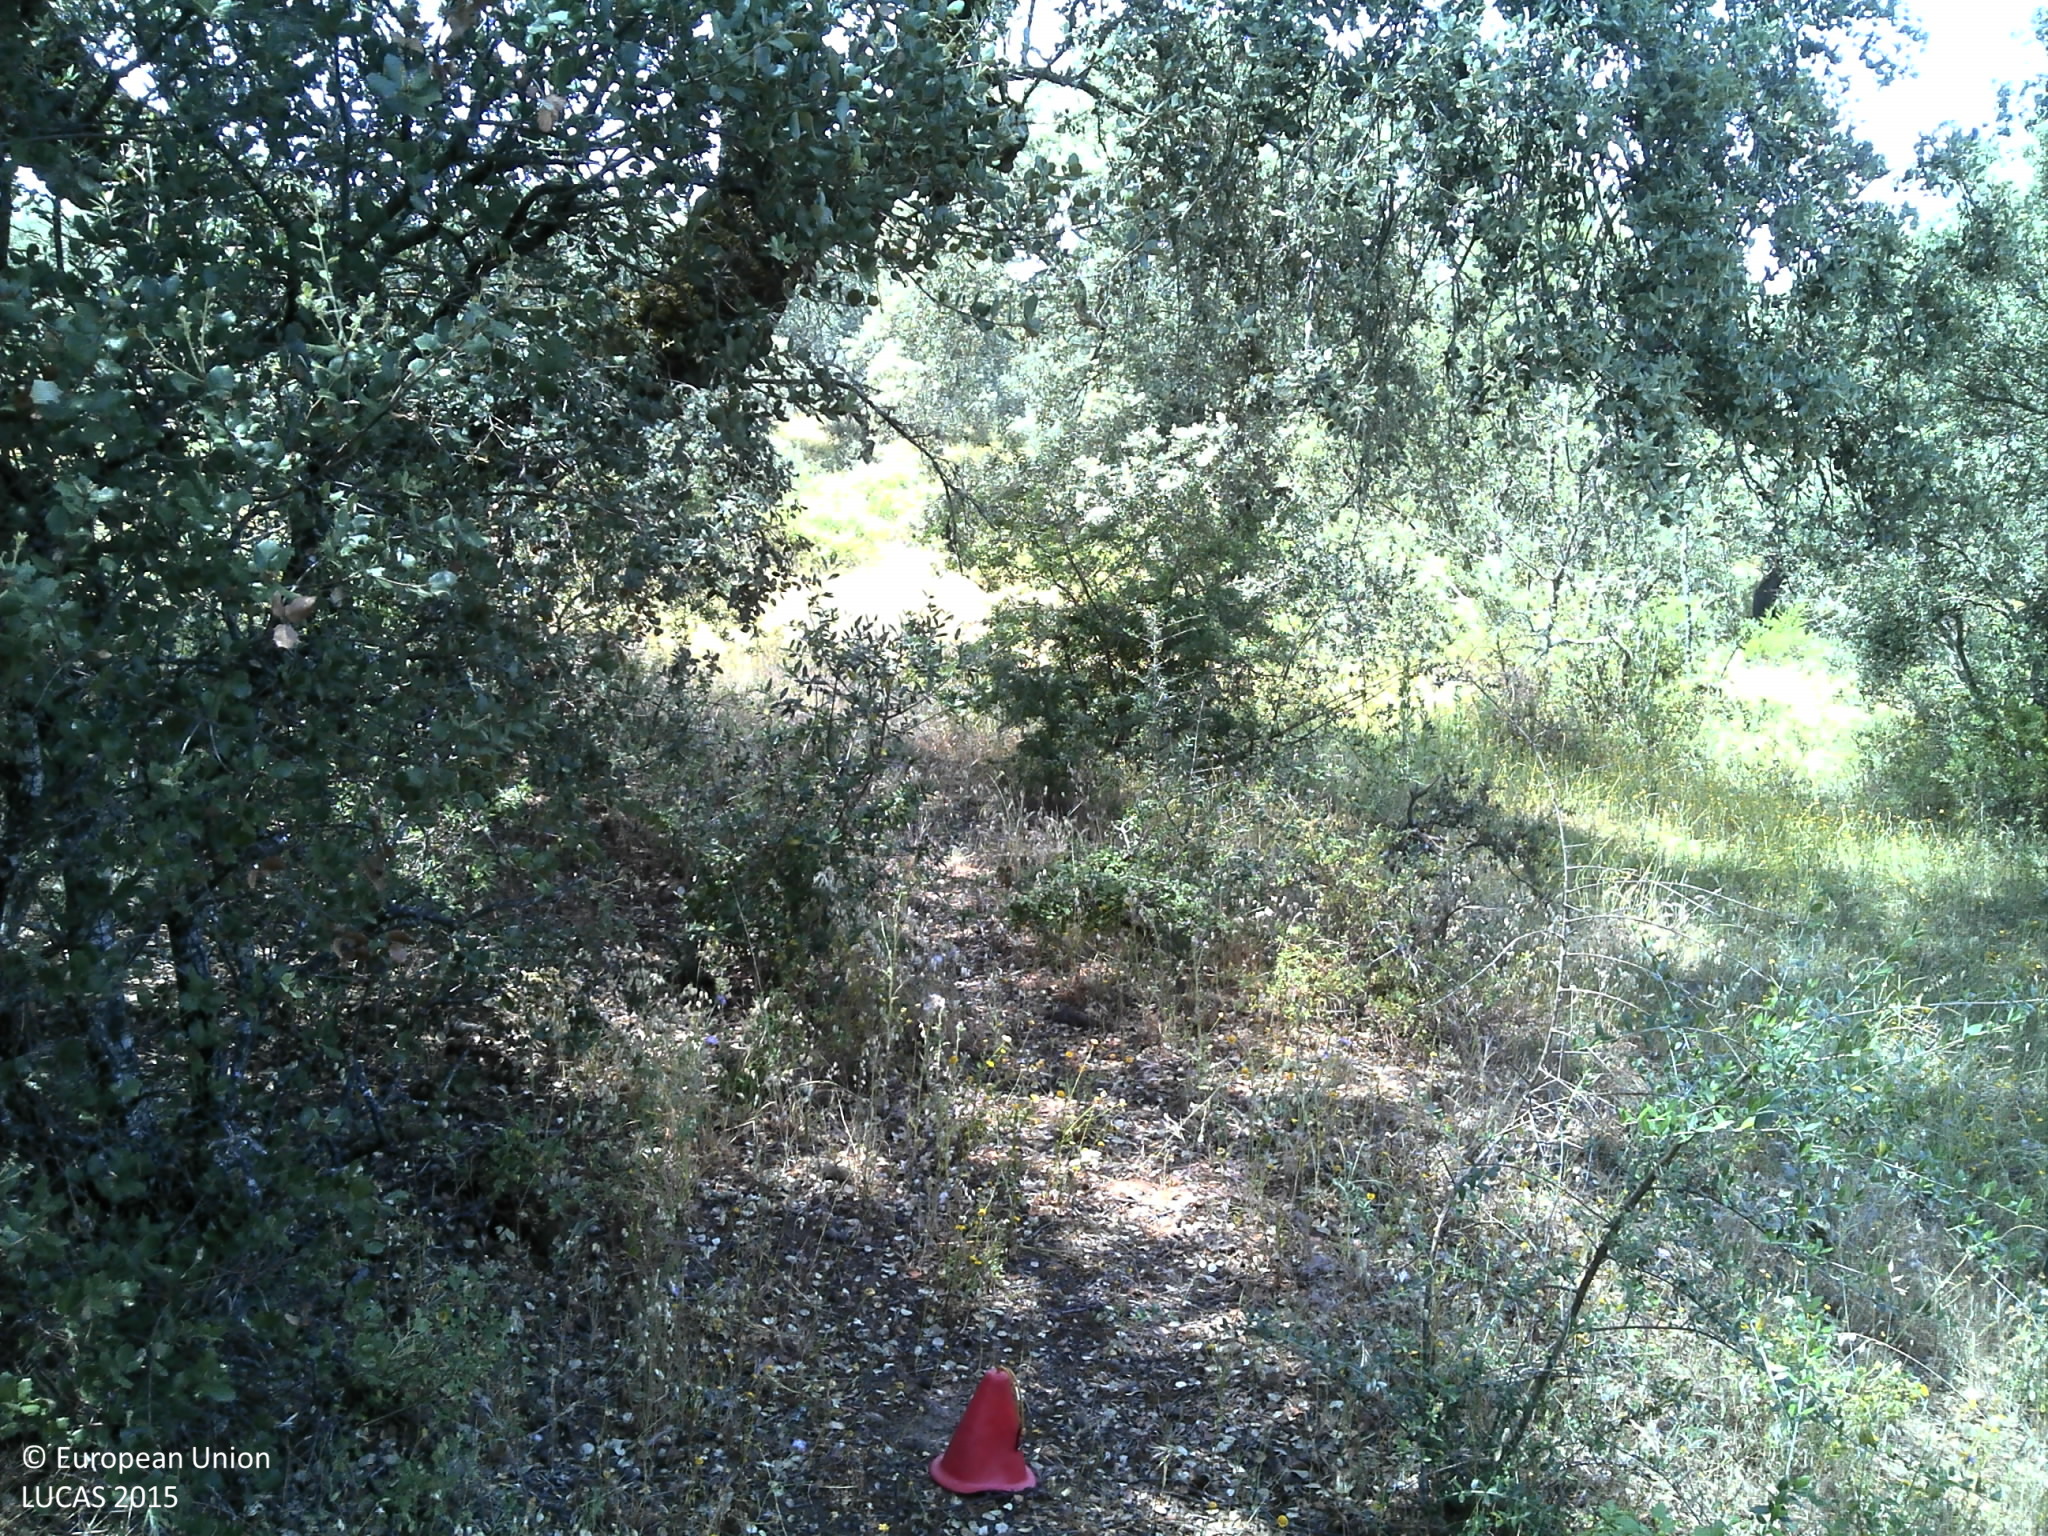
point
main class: Woodland
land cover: Broadleaved woodland
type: broadleaved evergreen forest
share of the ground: 50 - 75 %
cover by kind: broadleaved forest trees 60 %, shrubs 30 %, herbaceous plants 10 %
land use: Forestry
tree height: > 5 m
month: May
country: PT
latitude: 39.1743
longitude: -7.6266
